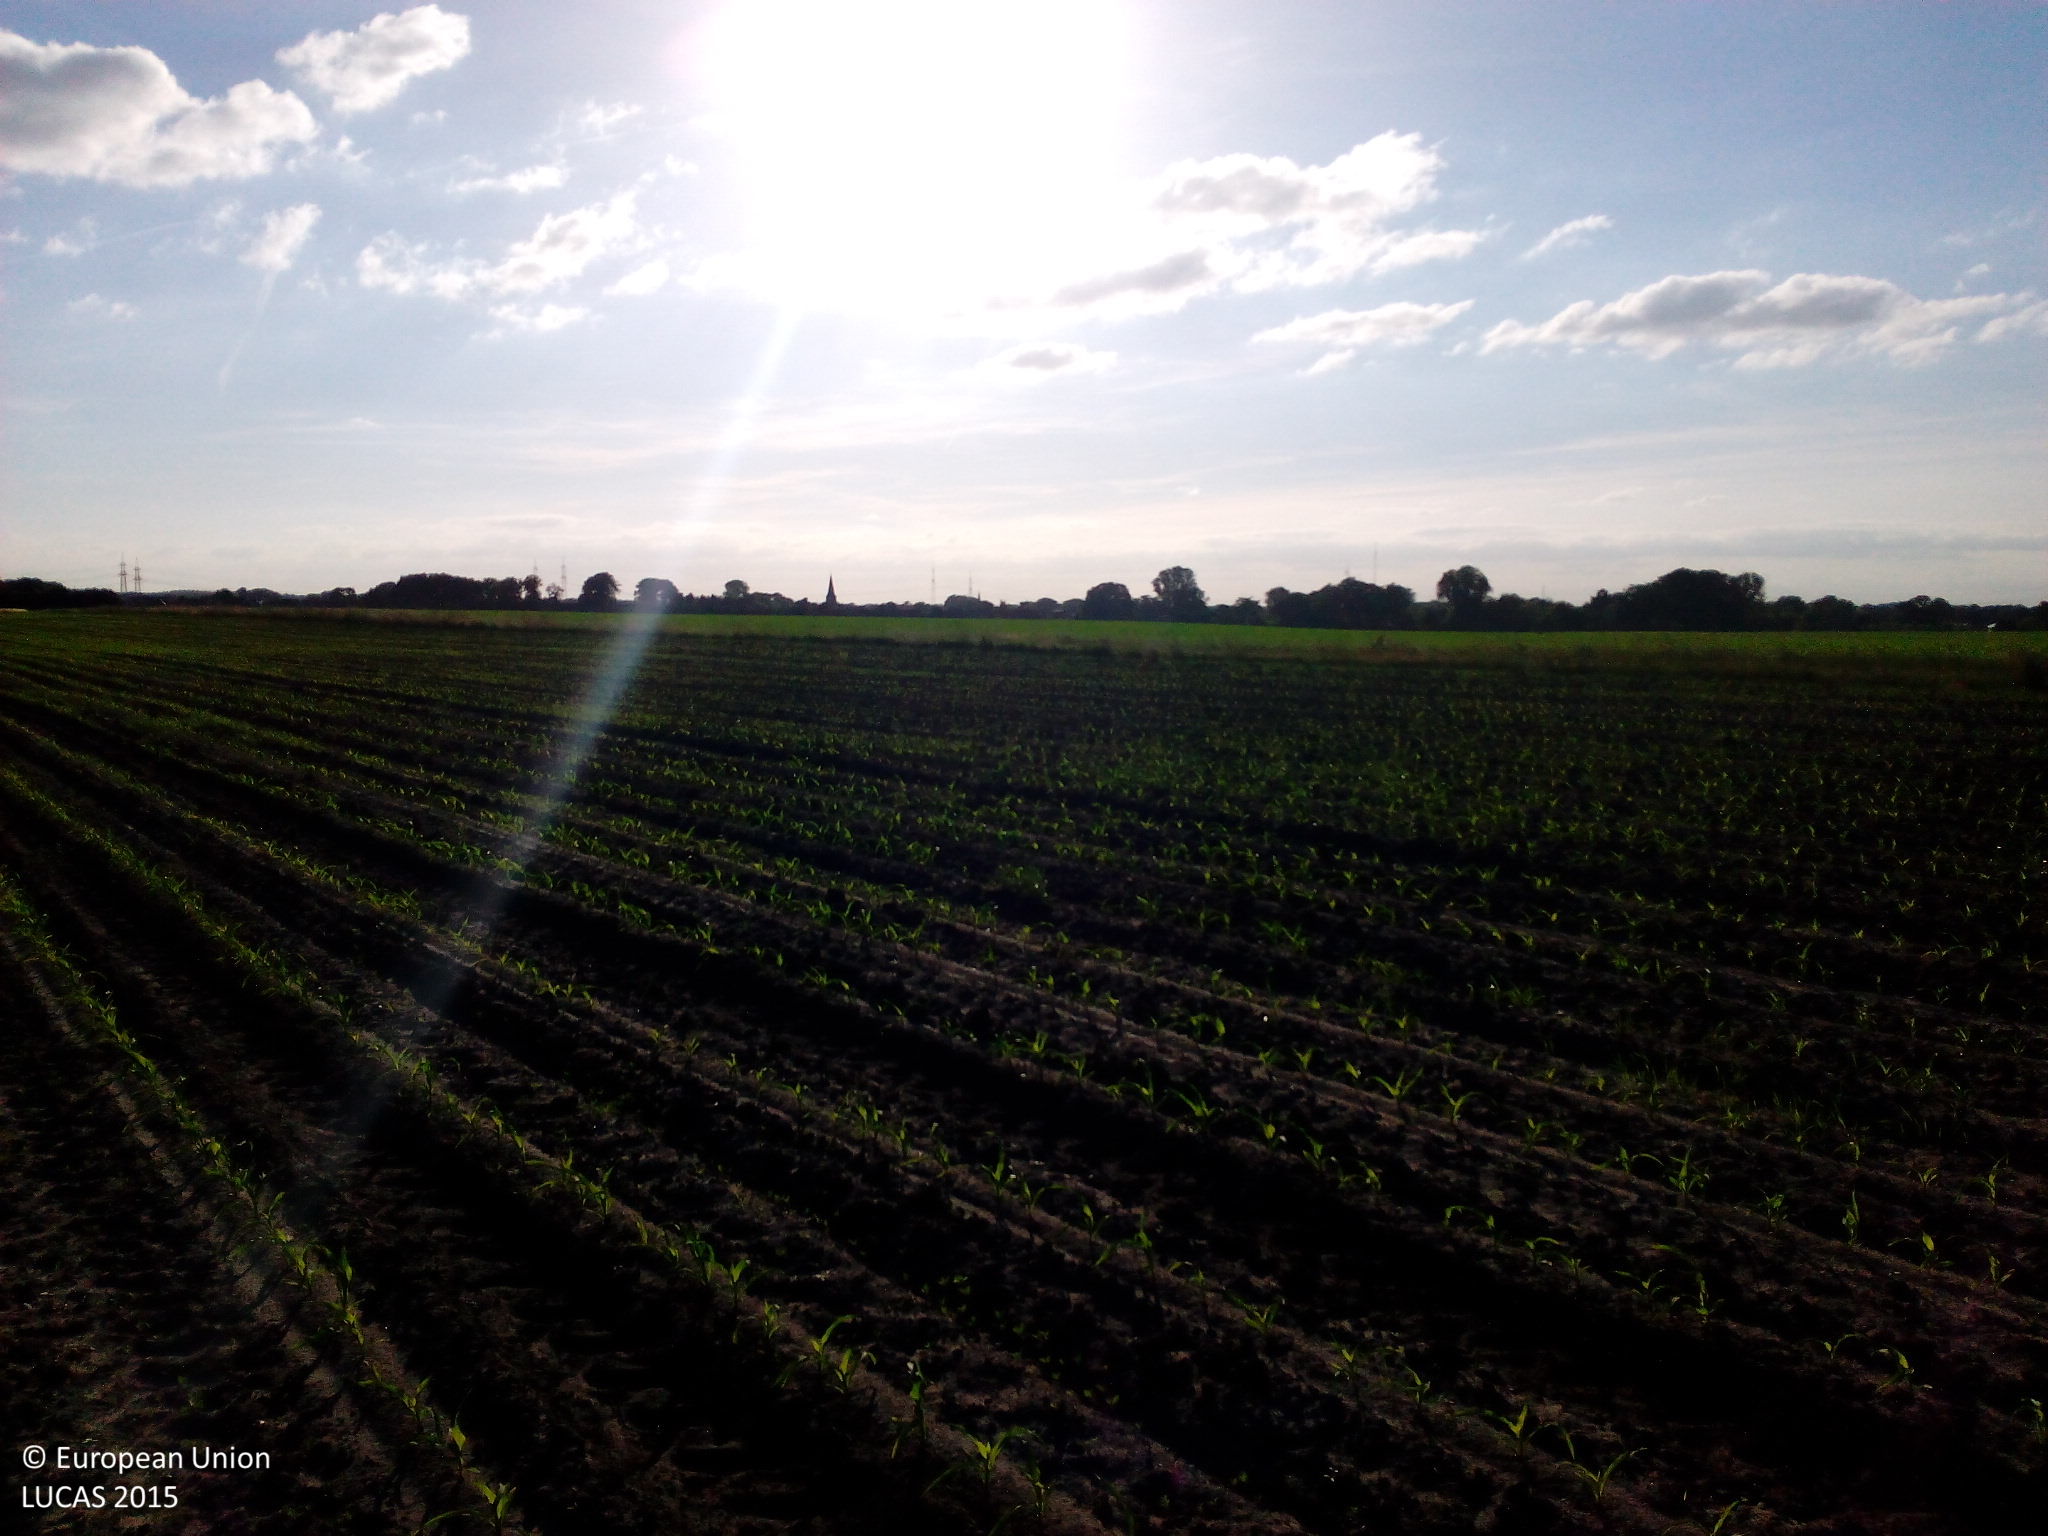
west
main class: Cropland
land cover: Maize
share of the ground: < 10 %
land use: Agriculture (excluding fallow land and kitchen gardens)
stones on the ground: < 10 %
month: June
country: DE
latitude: 52.5114
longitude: 7.4218
